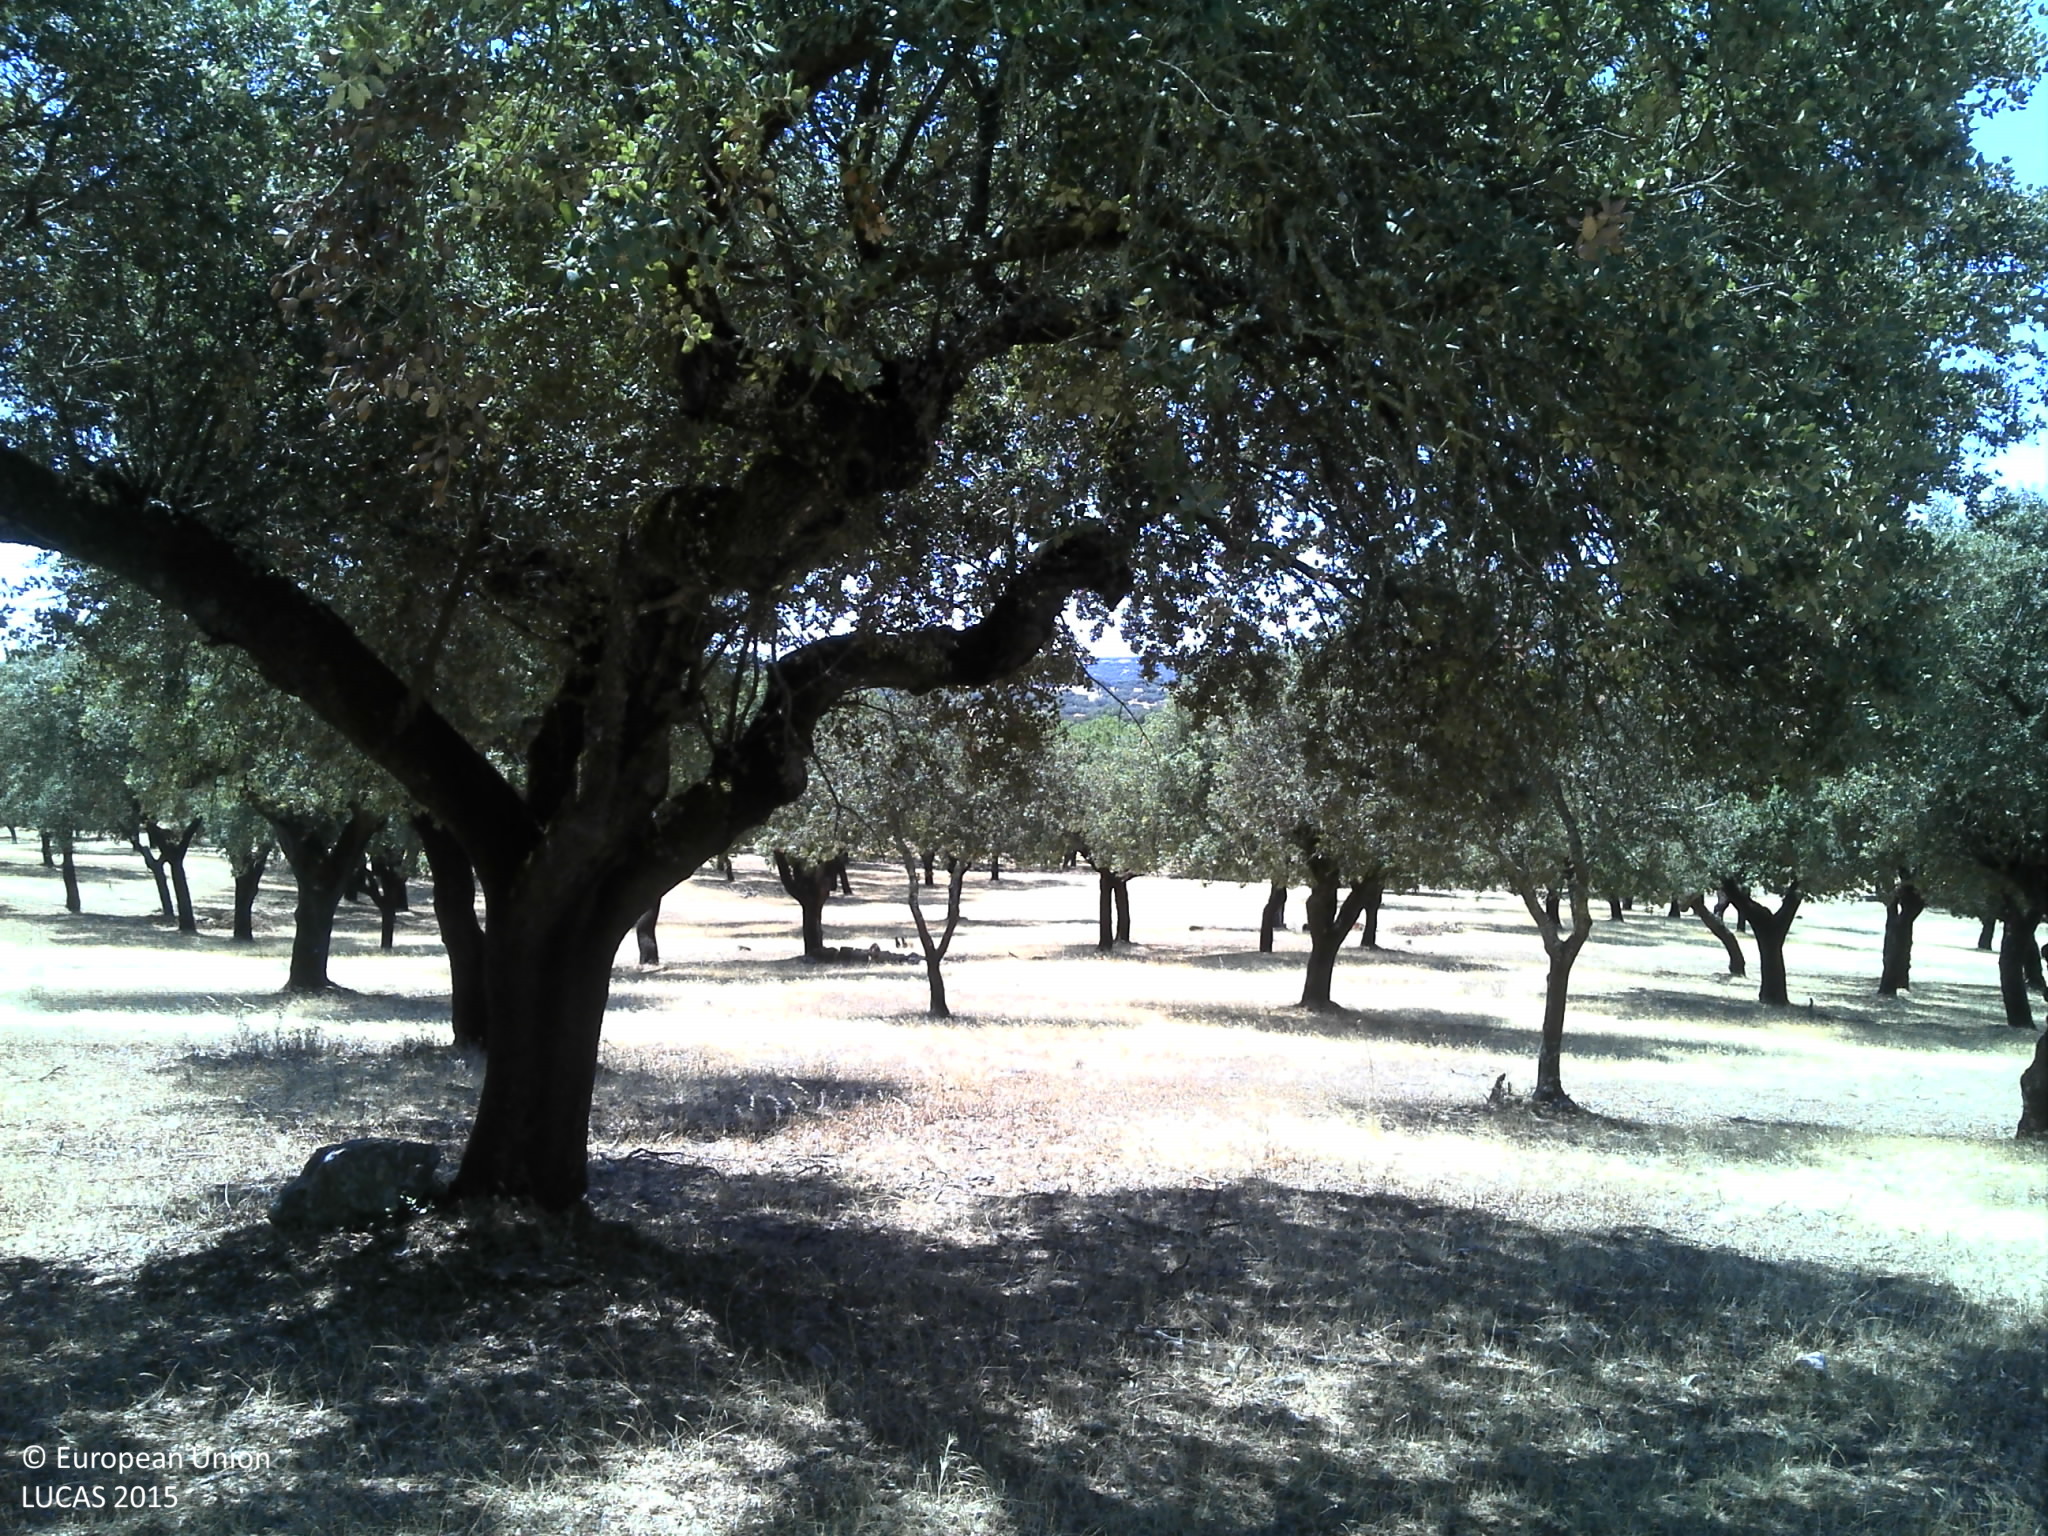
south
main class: Woodland
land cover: Broadleaved woodland
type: broadleaved evergreen forest
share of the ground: 50 - 75 %
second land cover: Grassland without tree/shrub cover
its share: 10 - 25 %
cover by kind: broadleaved forest trees 60 %, herbaceous plants 20 %, unconsolidated bare surface 20 %
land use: Forestry
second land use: Agriculture (excluding fallow land and kitchen gardens)
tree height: > 5 m
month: July
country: PT
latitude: 39.1536
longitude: -7.3365
